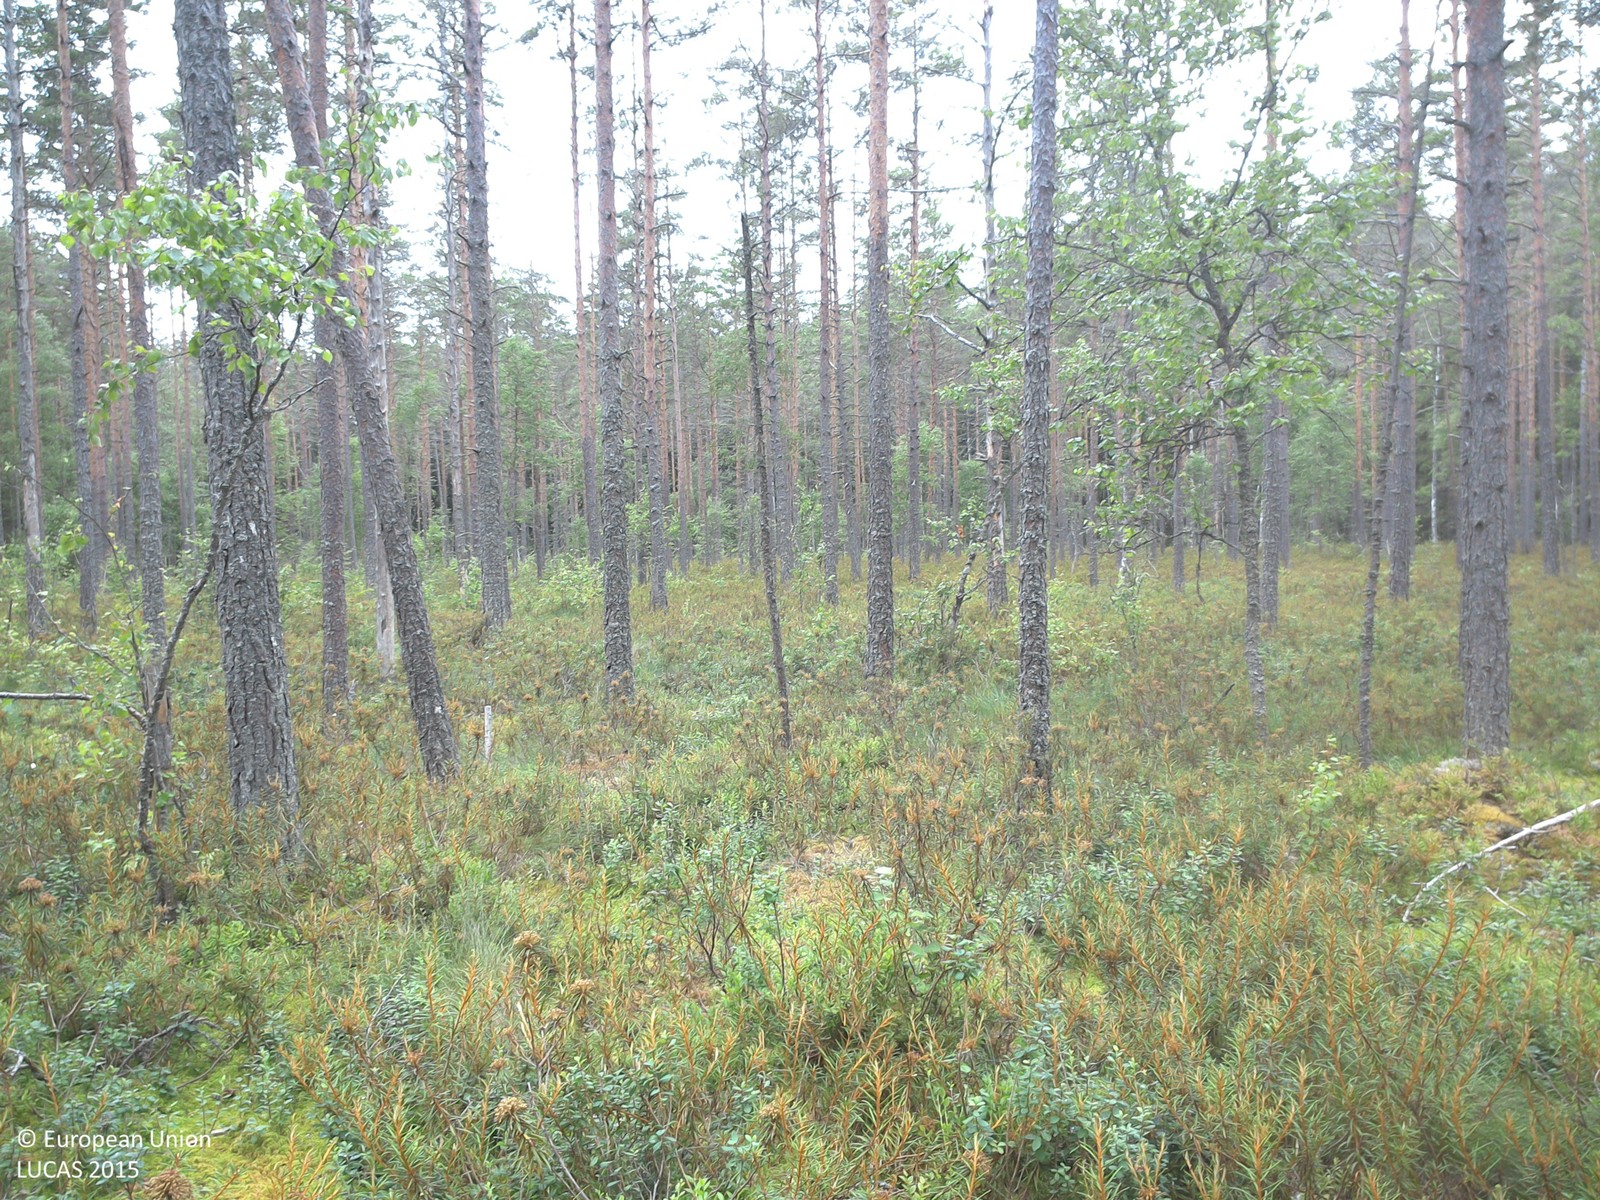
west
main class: Woodland
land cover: Pine dominated coniferous woodland
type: boreal forest
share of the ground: 25 - 50 %
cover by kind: coniferous forest trees 50 %, shrubs 40 %, herbaceous plants 5 %, lichens and mosses 5 %
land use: Forestry
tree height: > 5 m
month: July
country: SE
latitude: 57.7236
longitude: 16.0249
